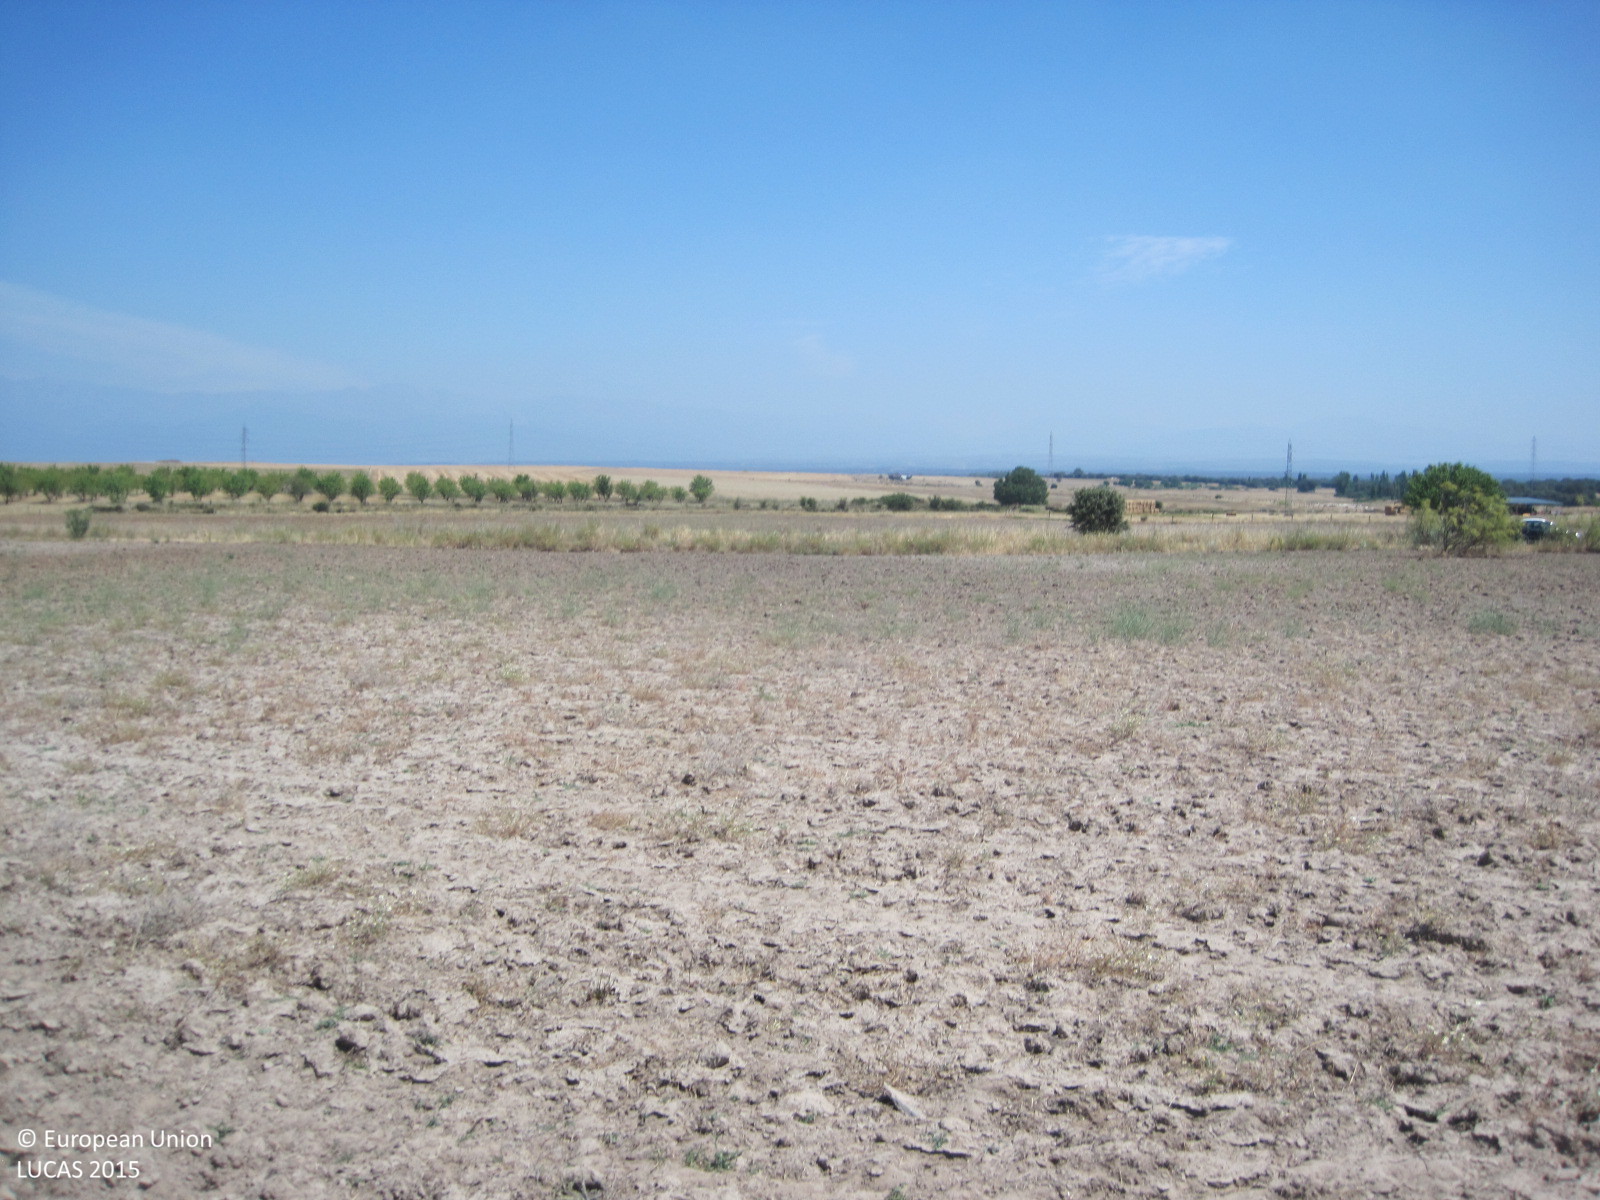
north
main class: Grassland
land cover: Spontaneously vegetated surfaces
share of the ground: > 75 %
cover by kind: herbaceous plants 90 %, unconsolidated bare surface 10 %
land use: Fallow land
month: July
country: ES
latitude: 39.9305
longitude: -5.1355
